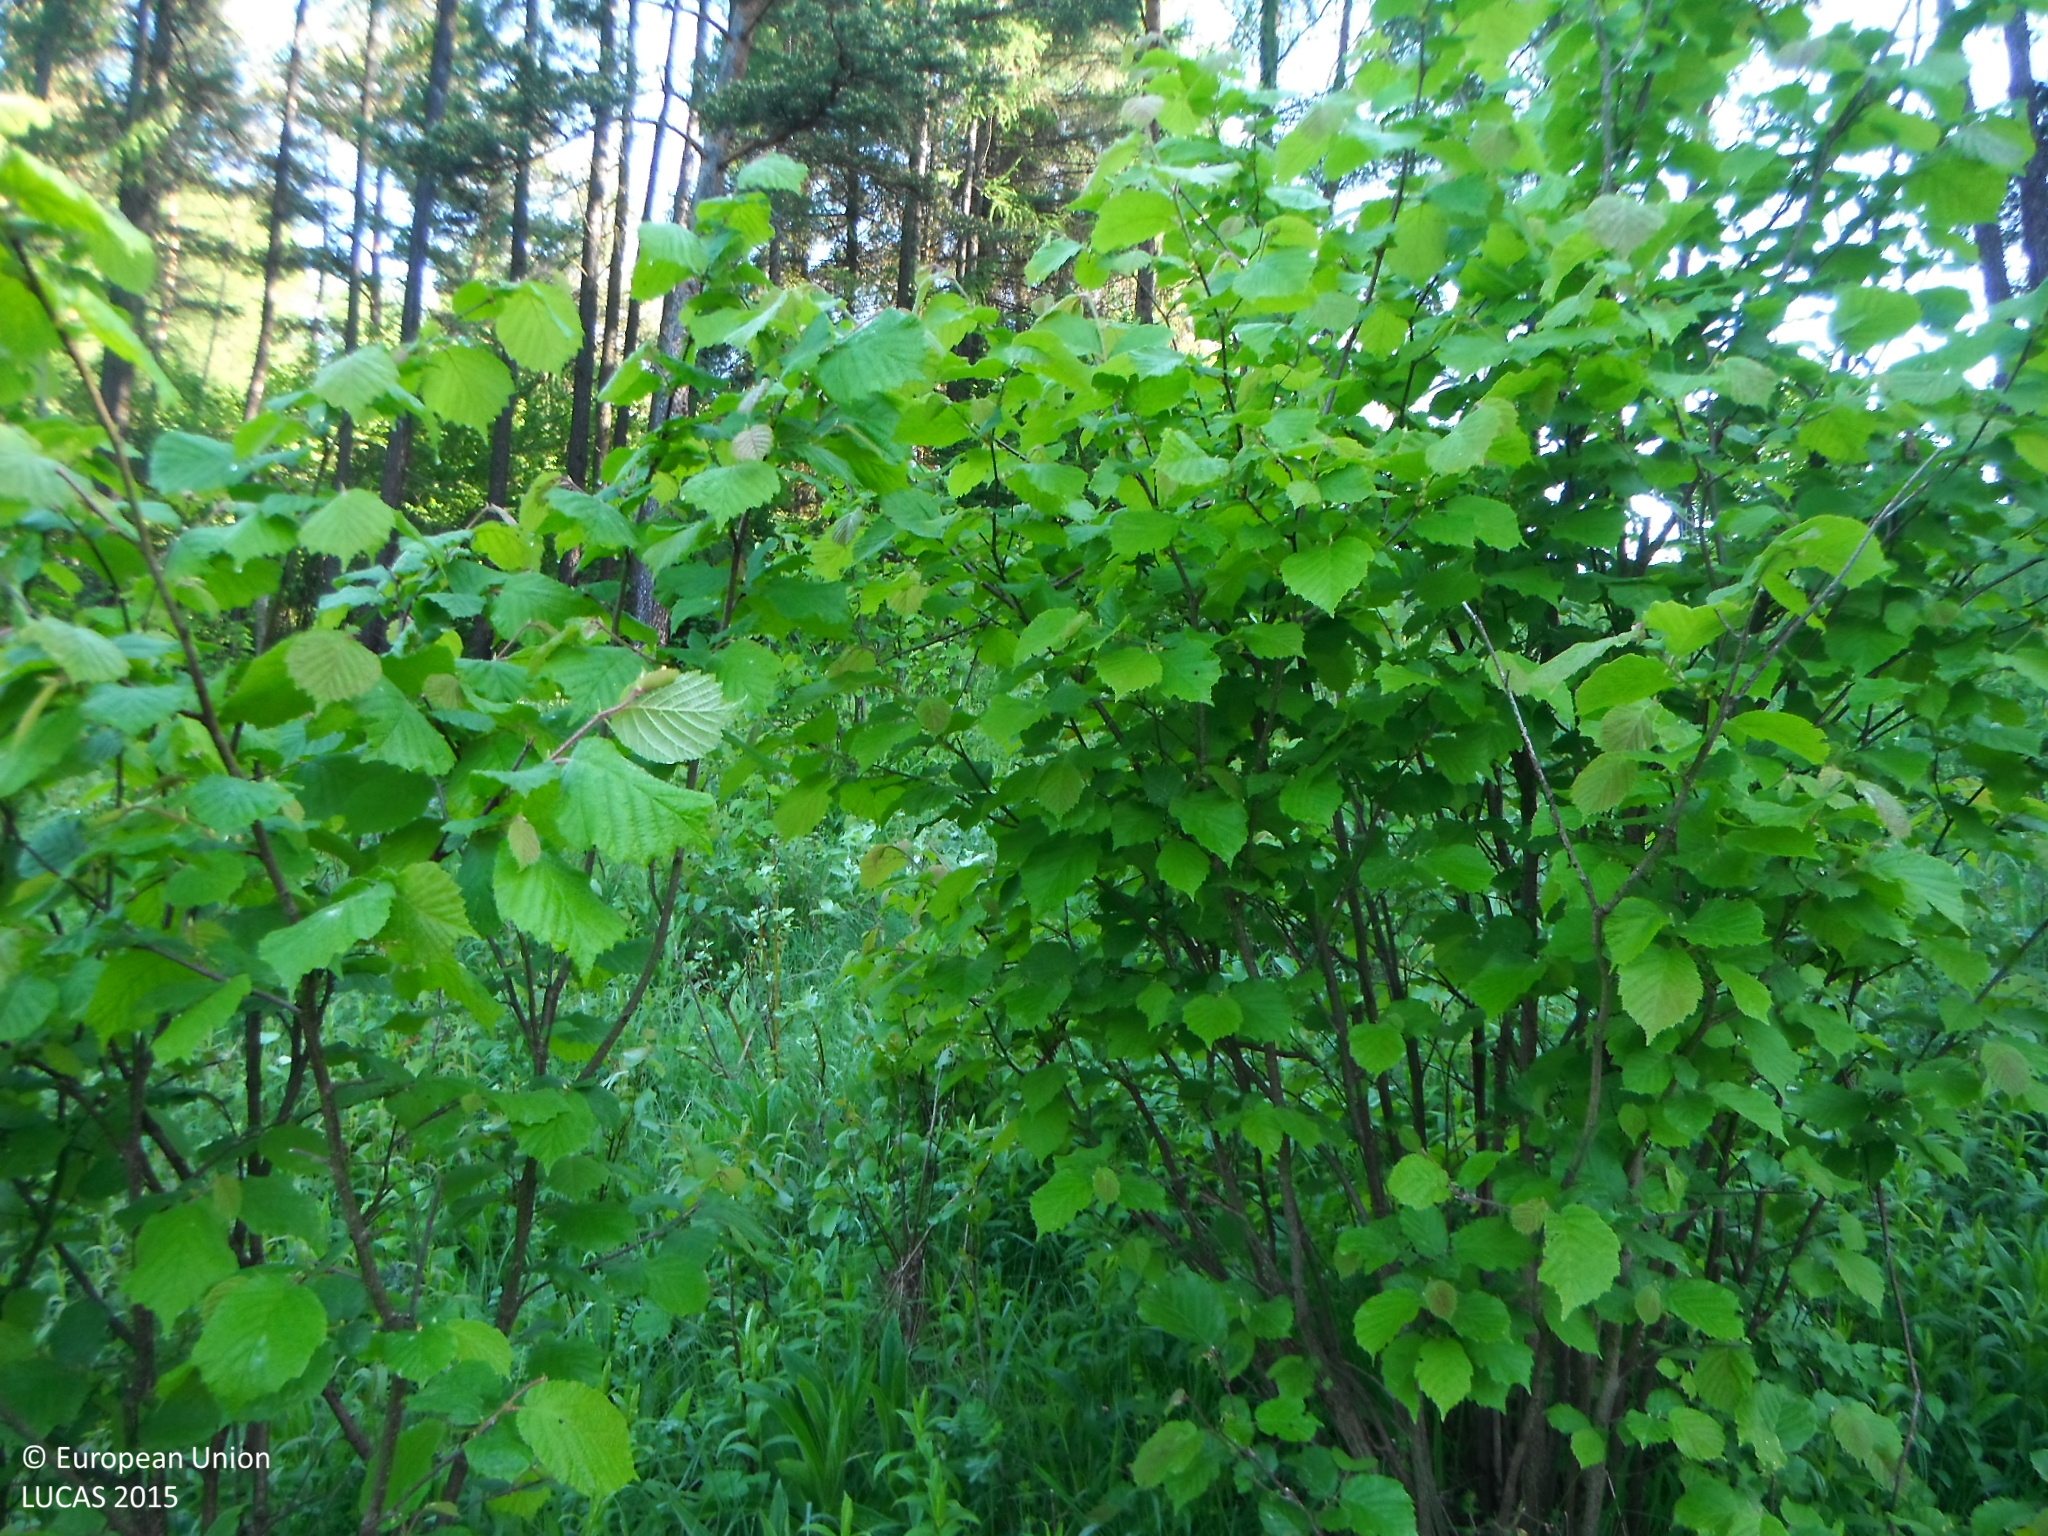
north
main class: Shrubland
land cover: Shrubland with sparse tree cover
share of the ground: > 75 %
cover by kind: shrubs 60 %, herbaceous plants 35 %, coniferous forest trees 5 %
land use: Forestry
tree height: > 5 m
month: June
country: SK
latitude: 49.0591
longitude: 19.9520
